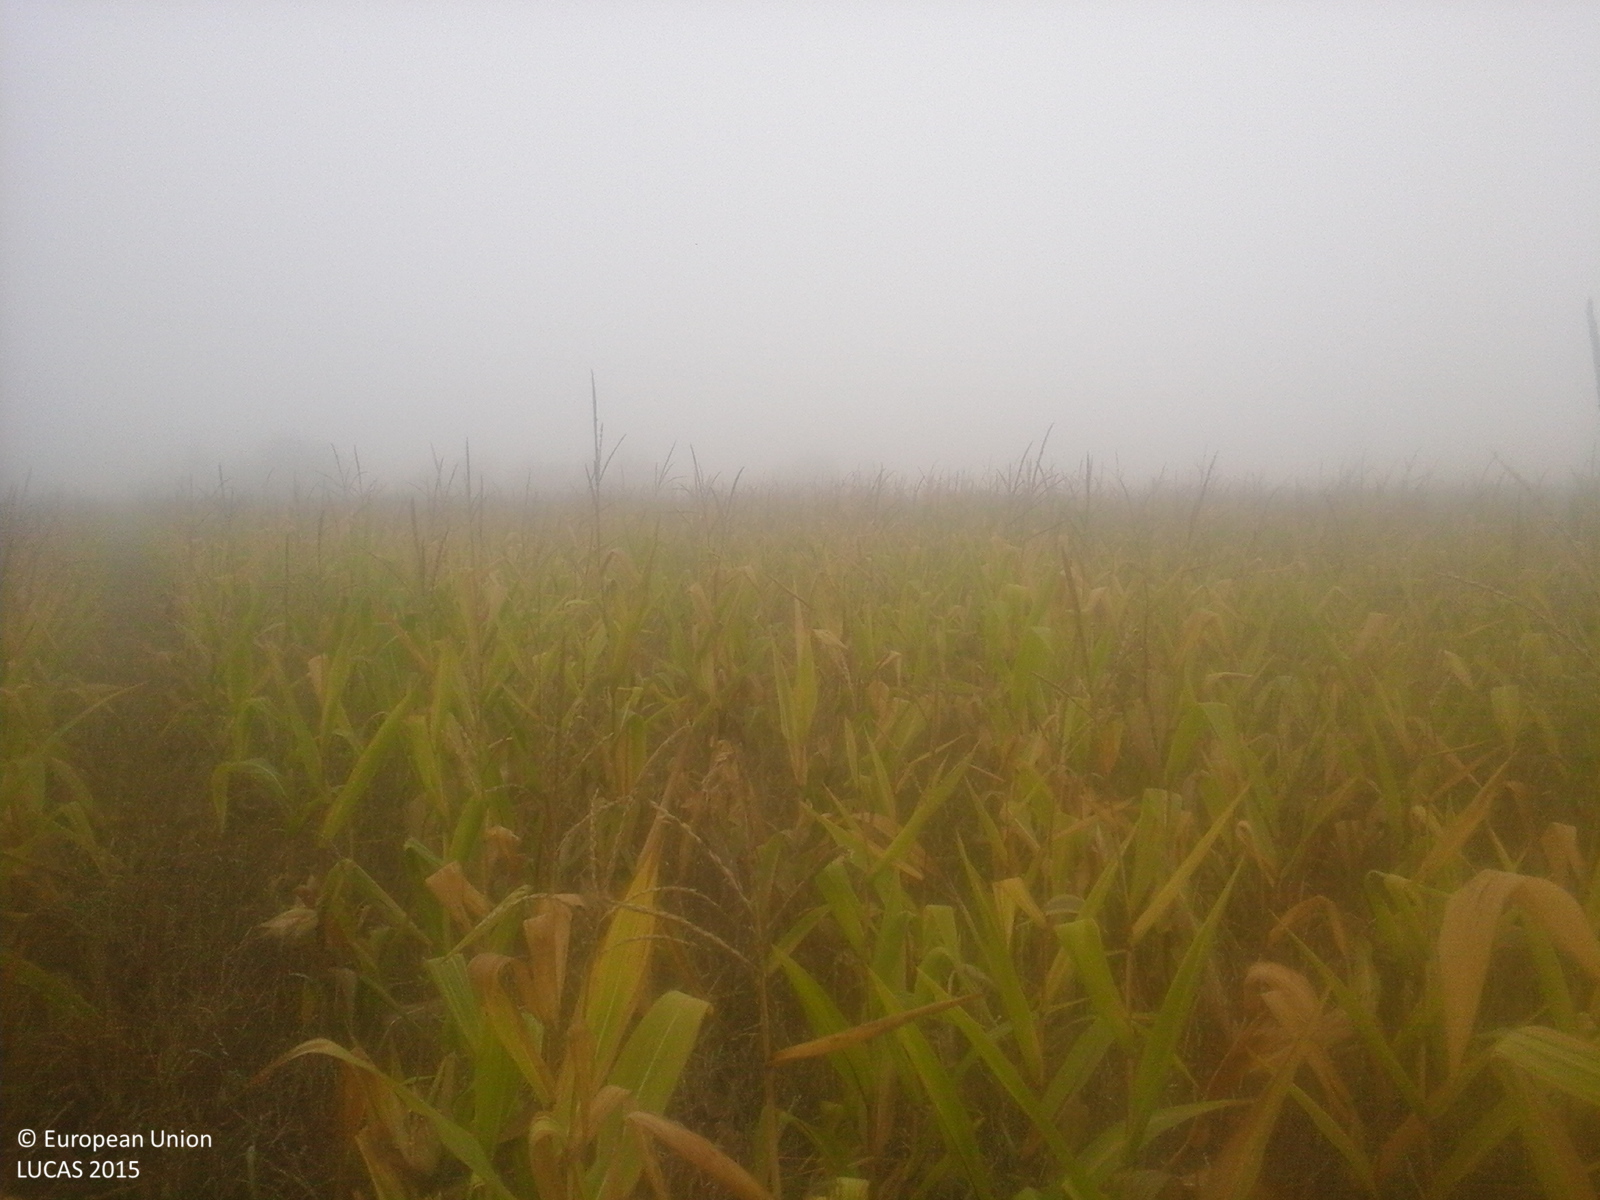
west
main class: Cropland
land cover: Maize
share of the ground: > 75 %
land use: Agriculture (excluding fallow land and kitchen gardens)
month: September
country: RO
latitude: 45.5852
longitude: 21.9713
